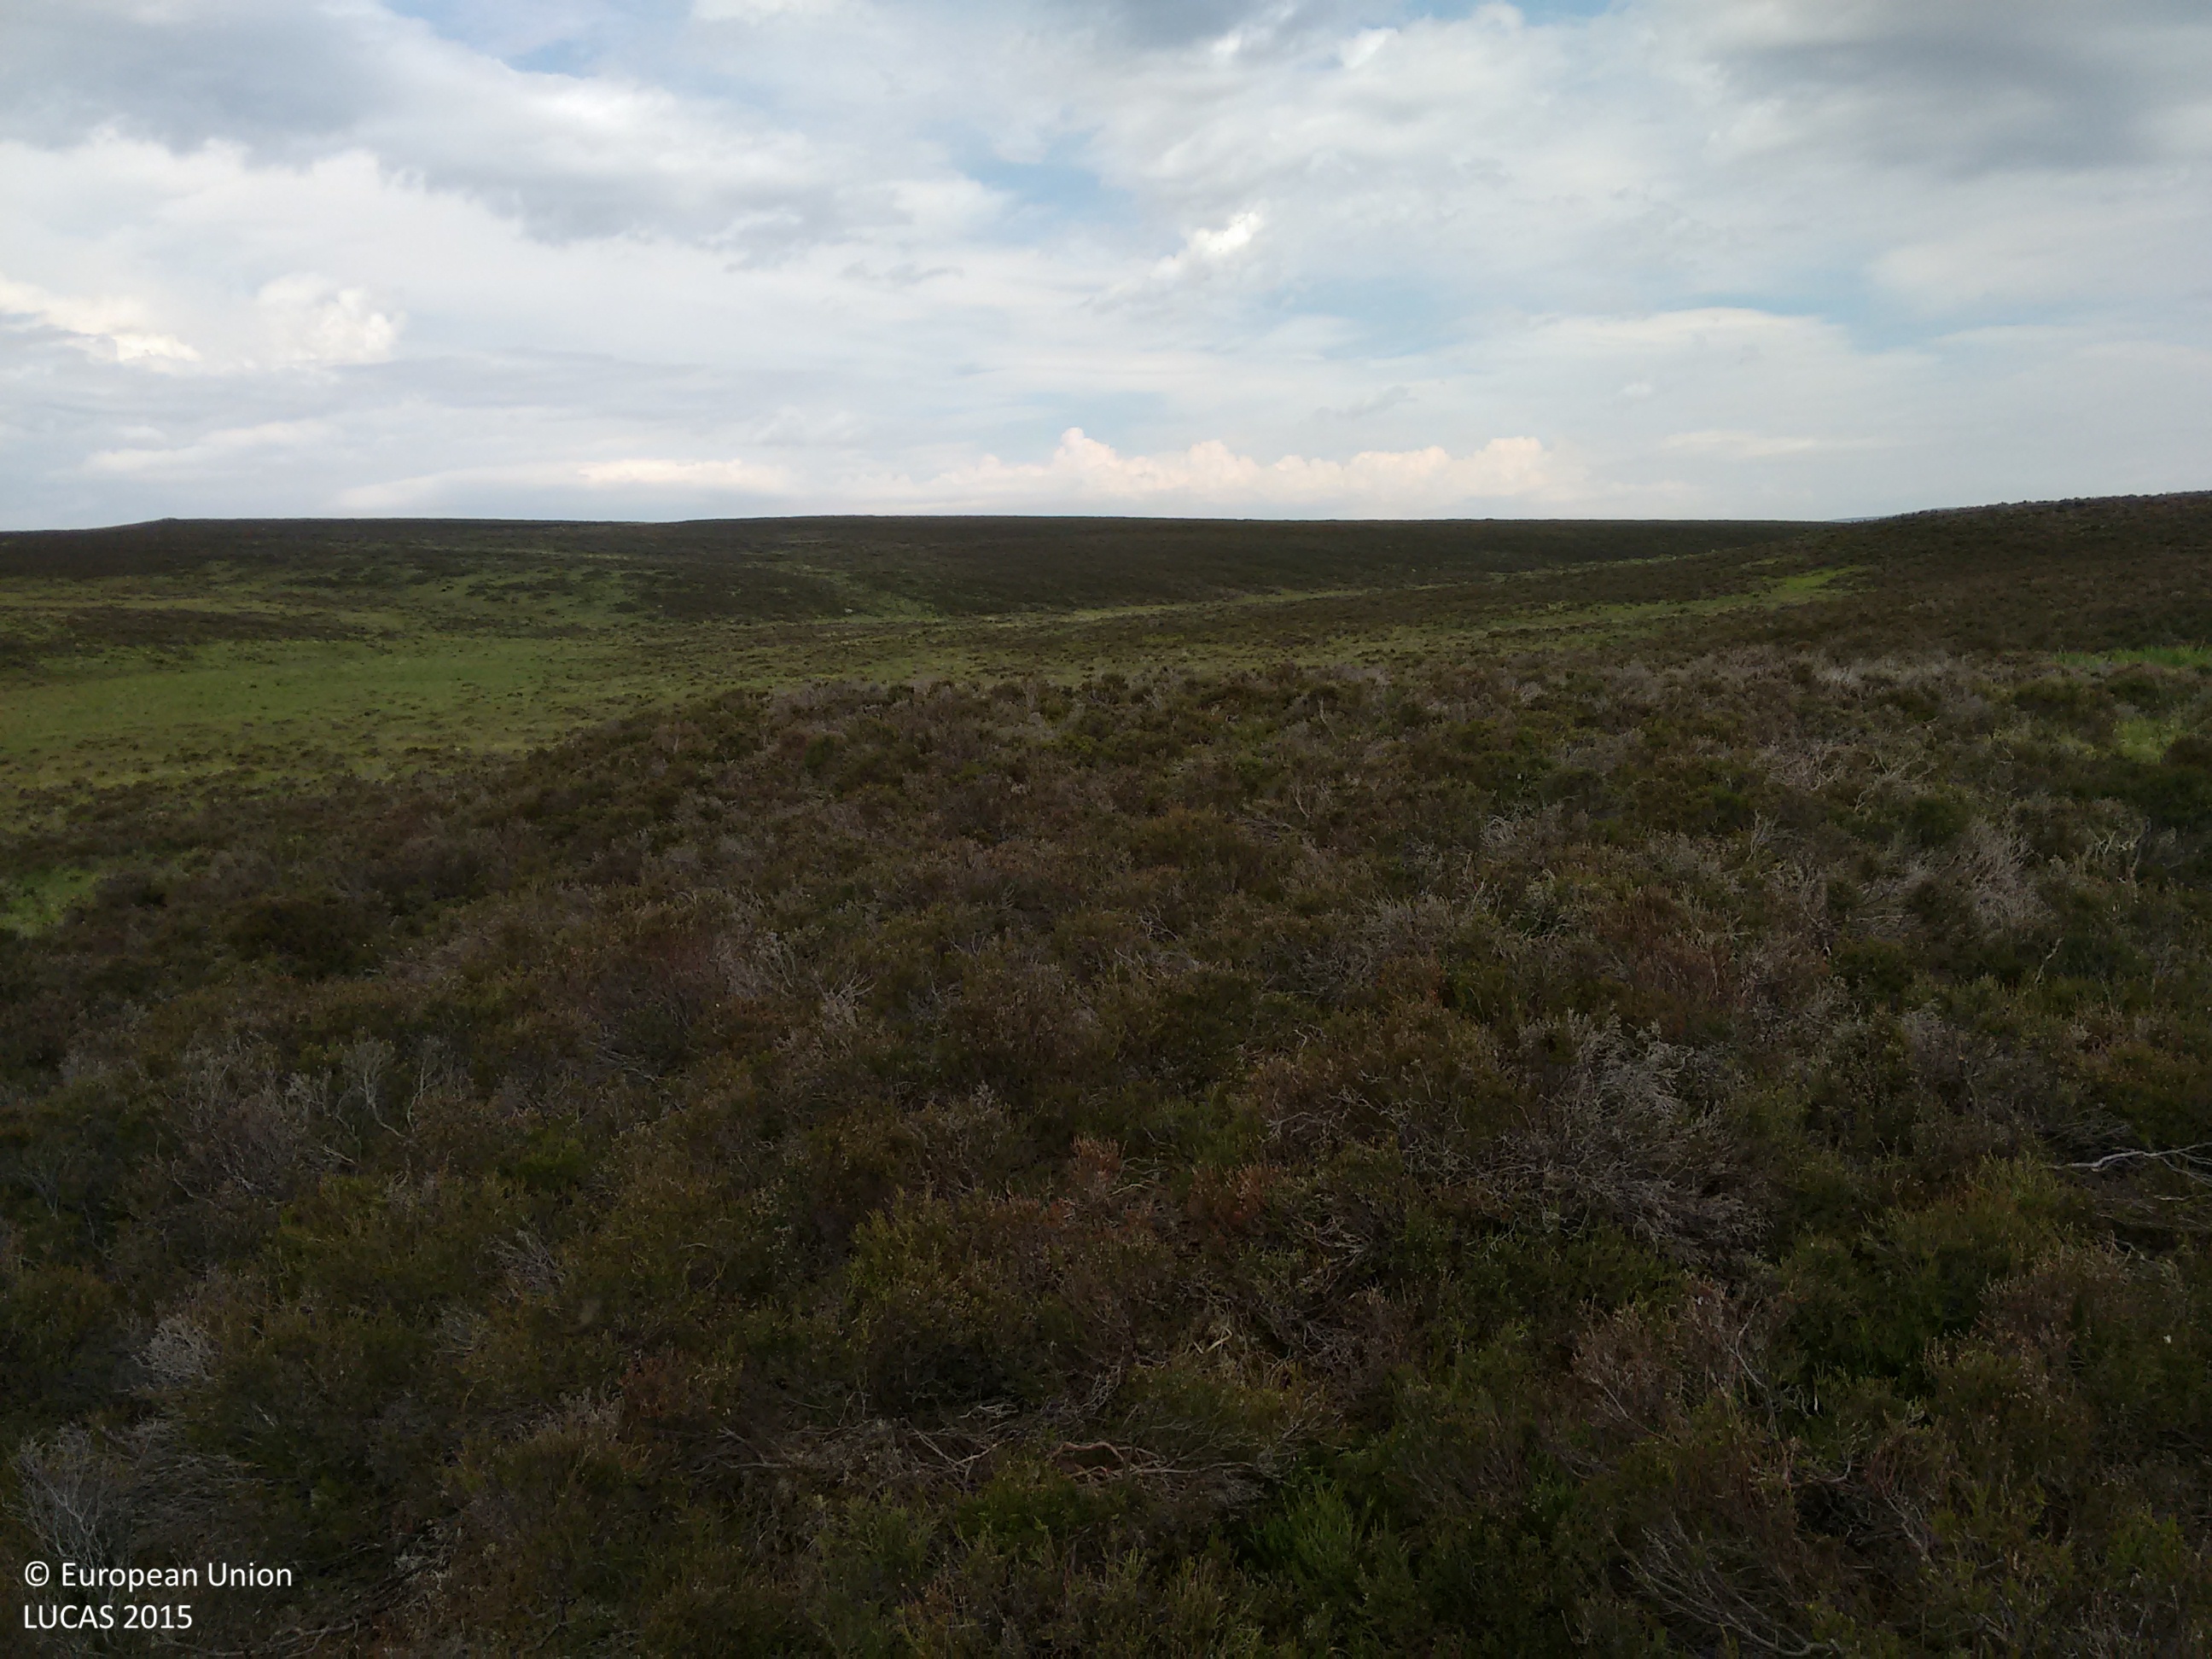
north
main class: Shrubland
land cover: Shrubland without tree cover
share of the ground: > 75 %
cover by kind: shrubs 95 %, herbaceous plants 5 %
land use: Semi-natural and natural areas not in use
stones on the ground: < 10 %
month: July
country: GB
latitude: 56.7391
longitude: -3.9297
